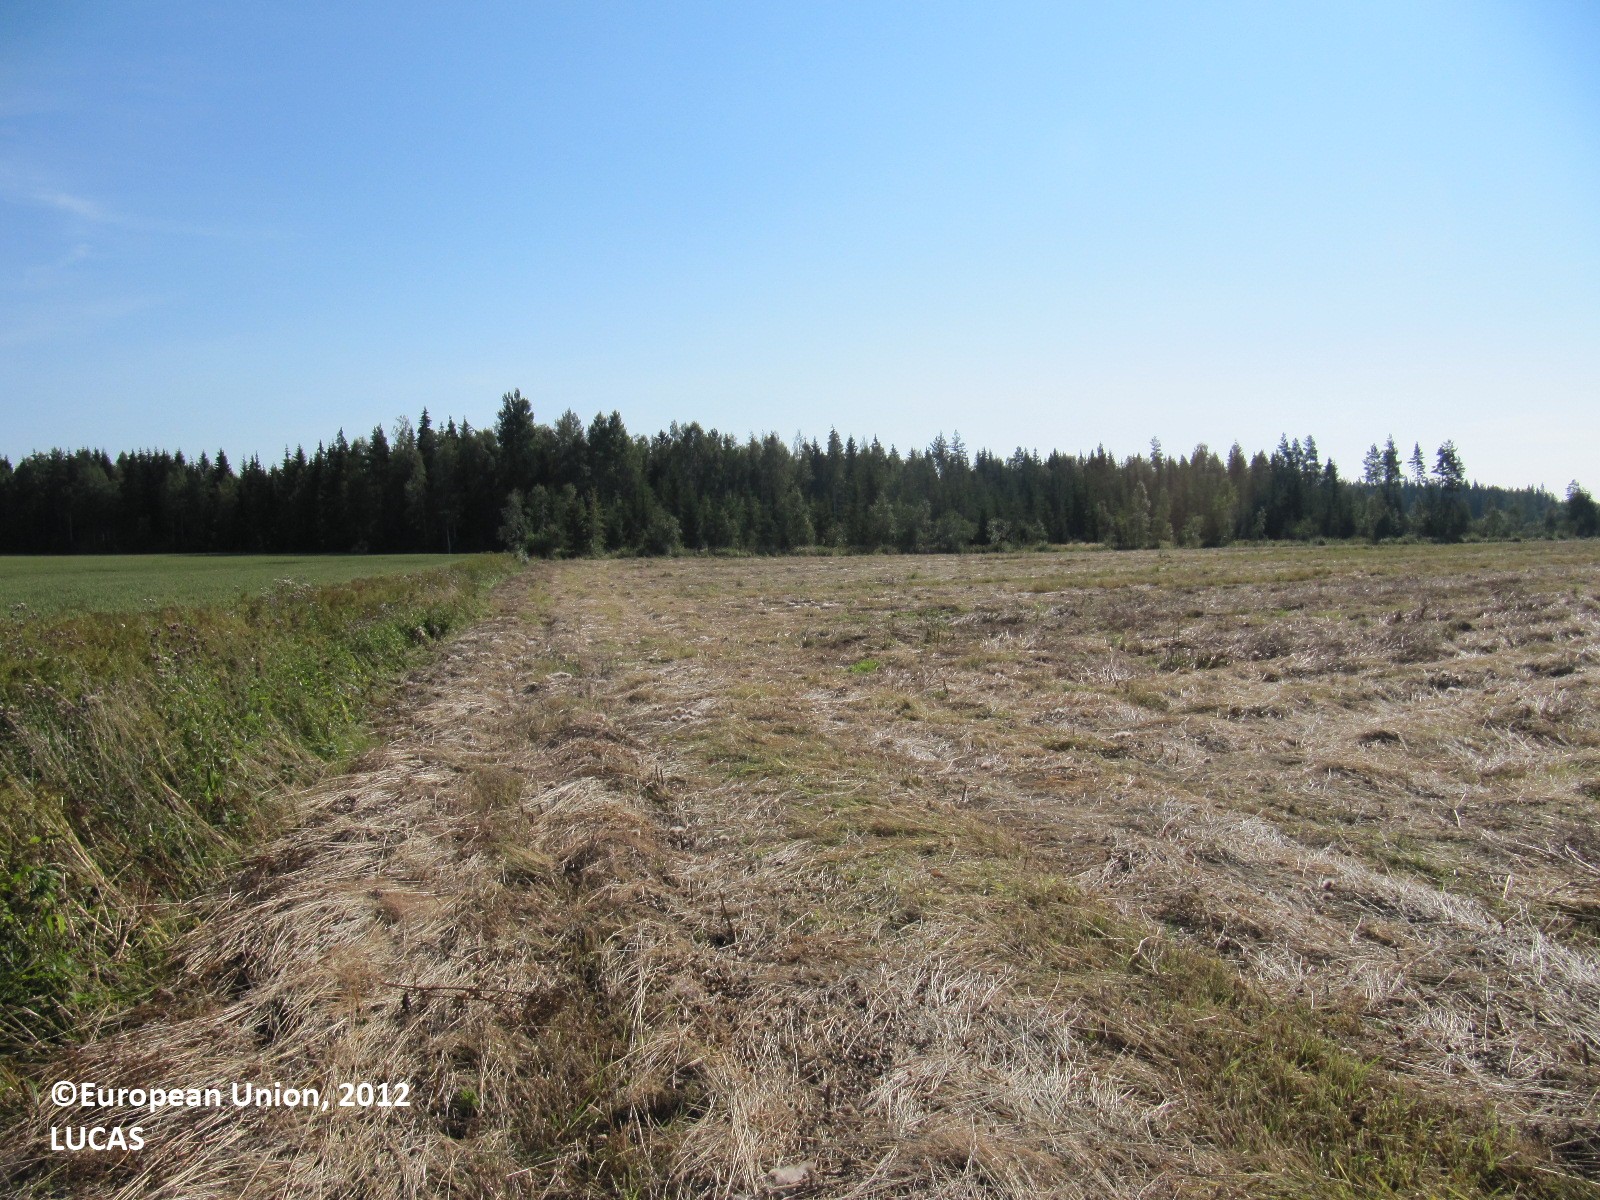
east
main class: Grassland
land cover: Grassland without tree/shrub cover
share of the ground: > 75 %
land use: Agriculture (excluding fallow land and kitchen gardens)
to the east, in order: Grassland without tree/shrub cover; Ditches and canals; Spruce dominated mixed woodland
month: August
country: FI
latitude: 60.7080
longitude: 24.5255
